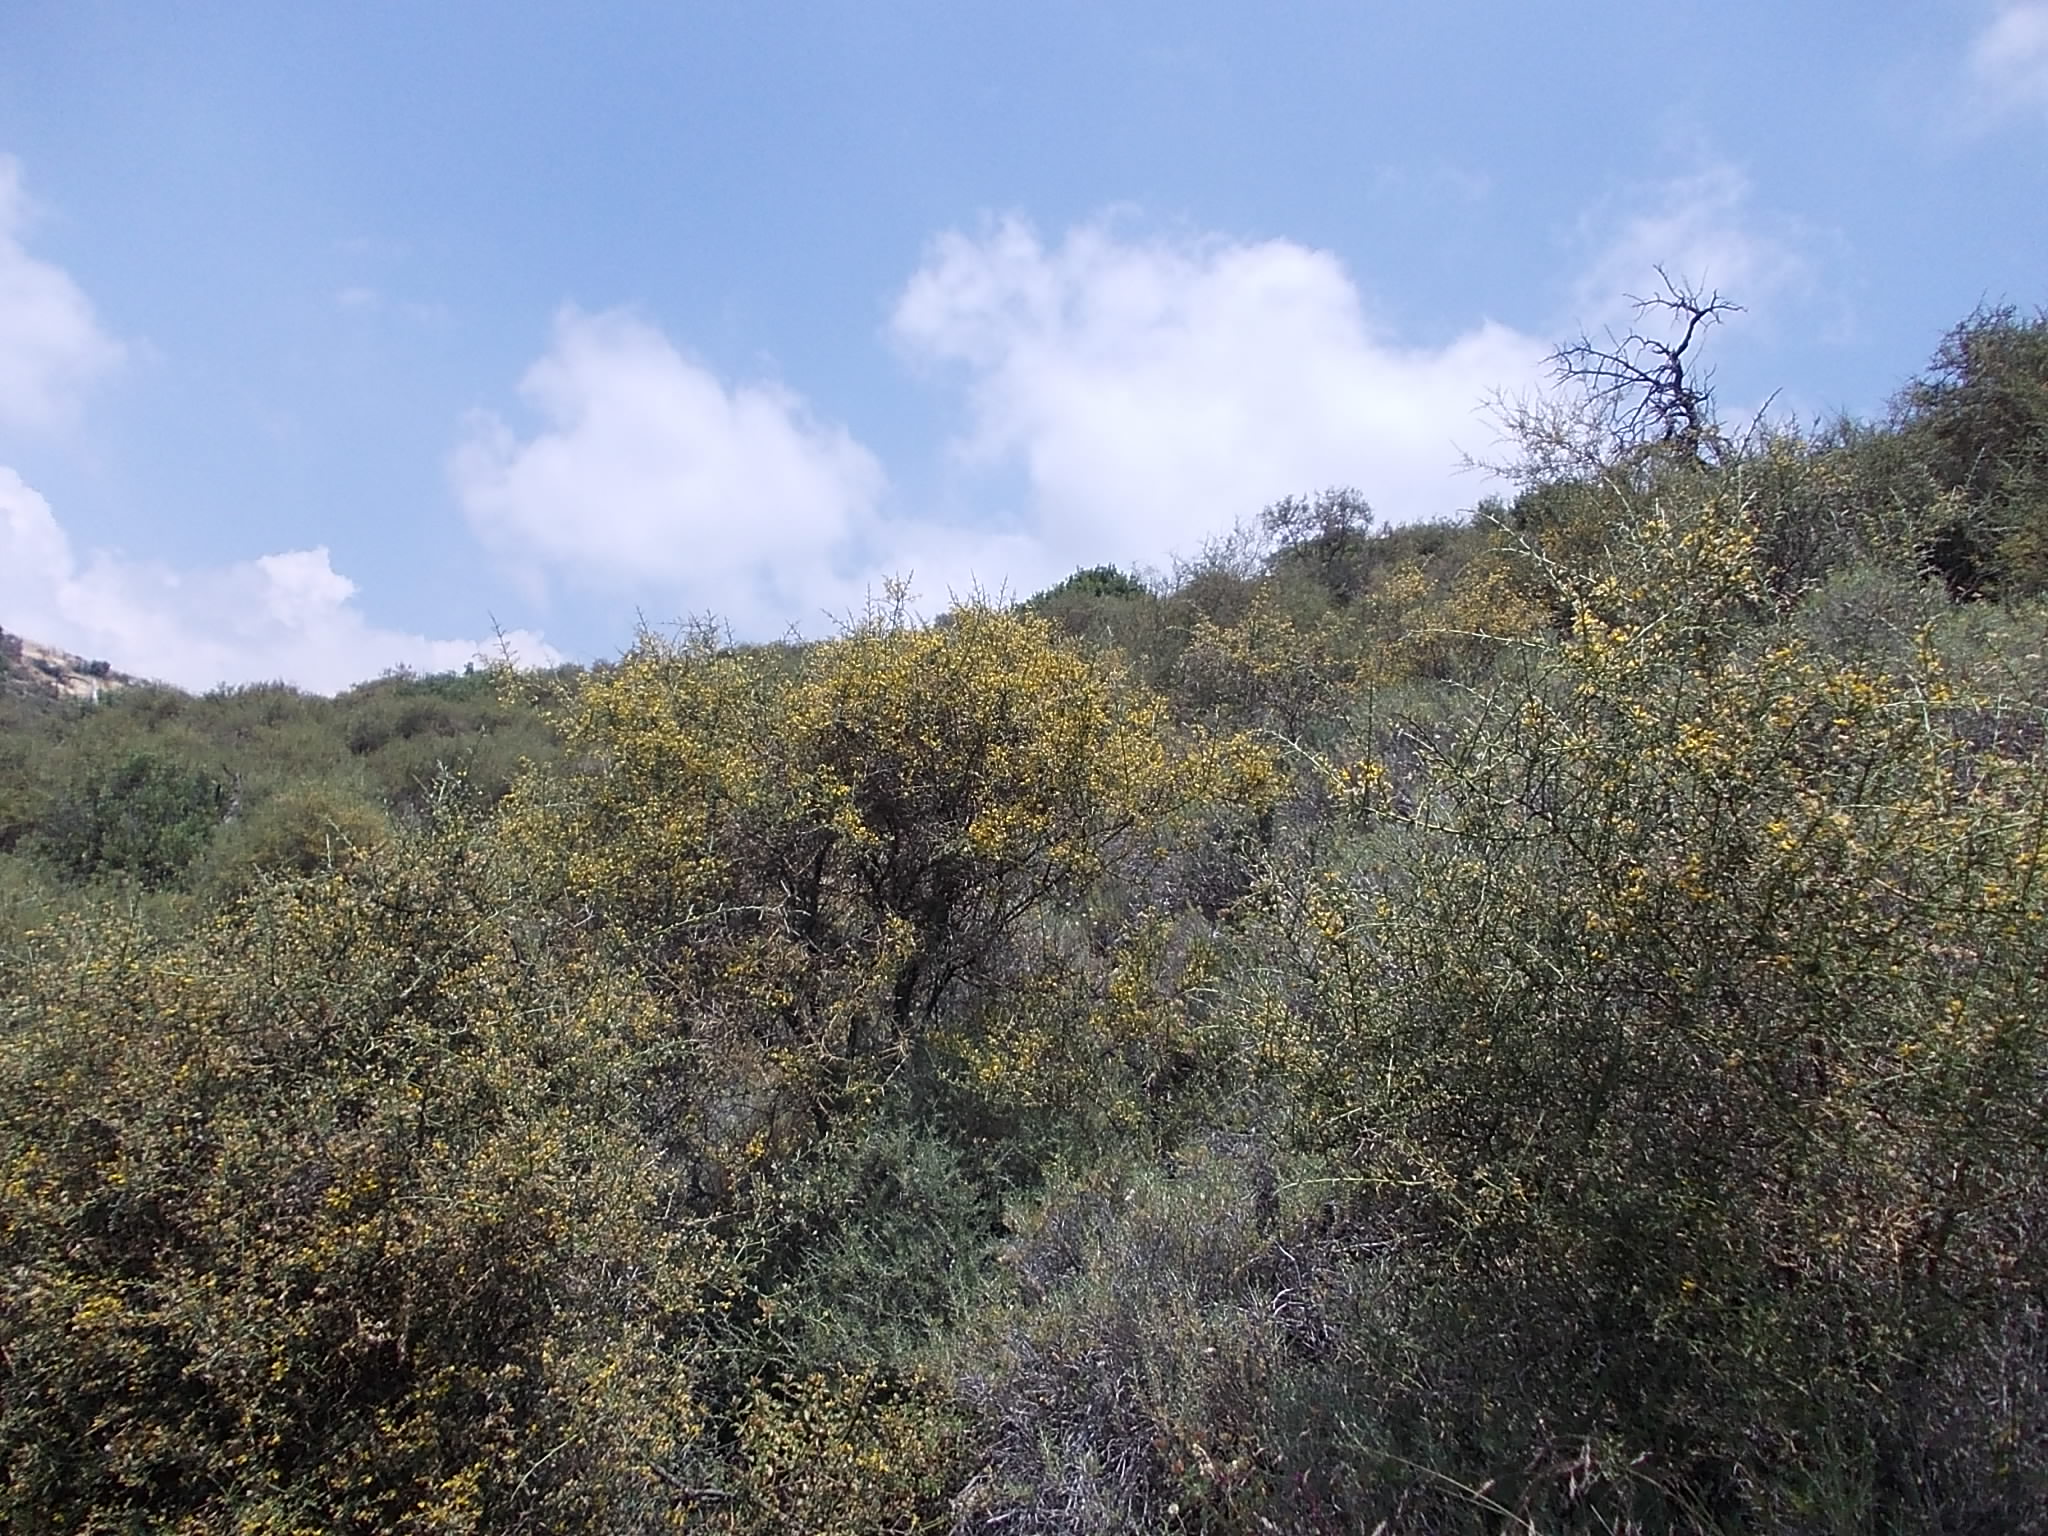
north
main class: Shrubland
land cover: Shrubland without tree cover
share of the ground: > 75 %
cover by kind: shrubs 85 %, herbaceous plants 10 %, unconsolidated bare surface 5 %
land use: Semi-natural and natural areas not in use
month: June
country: CY
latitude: 34.7931
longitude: 32.9300
